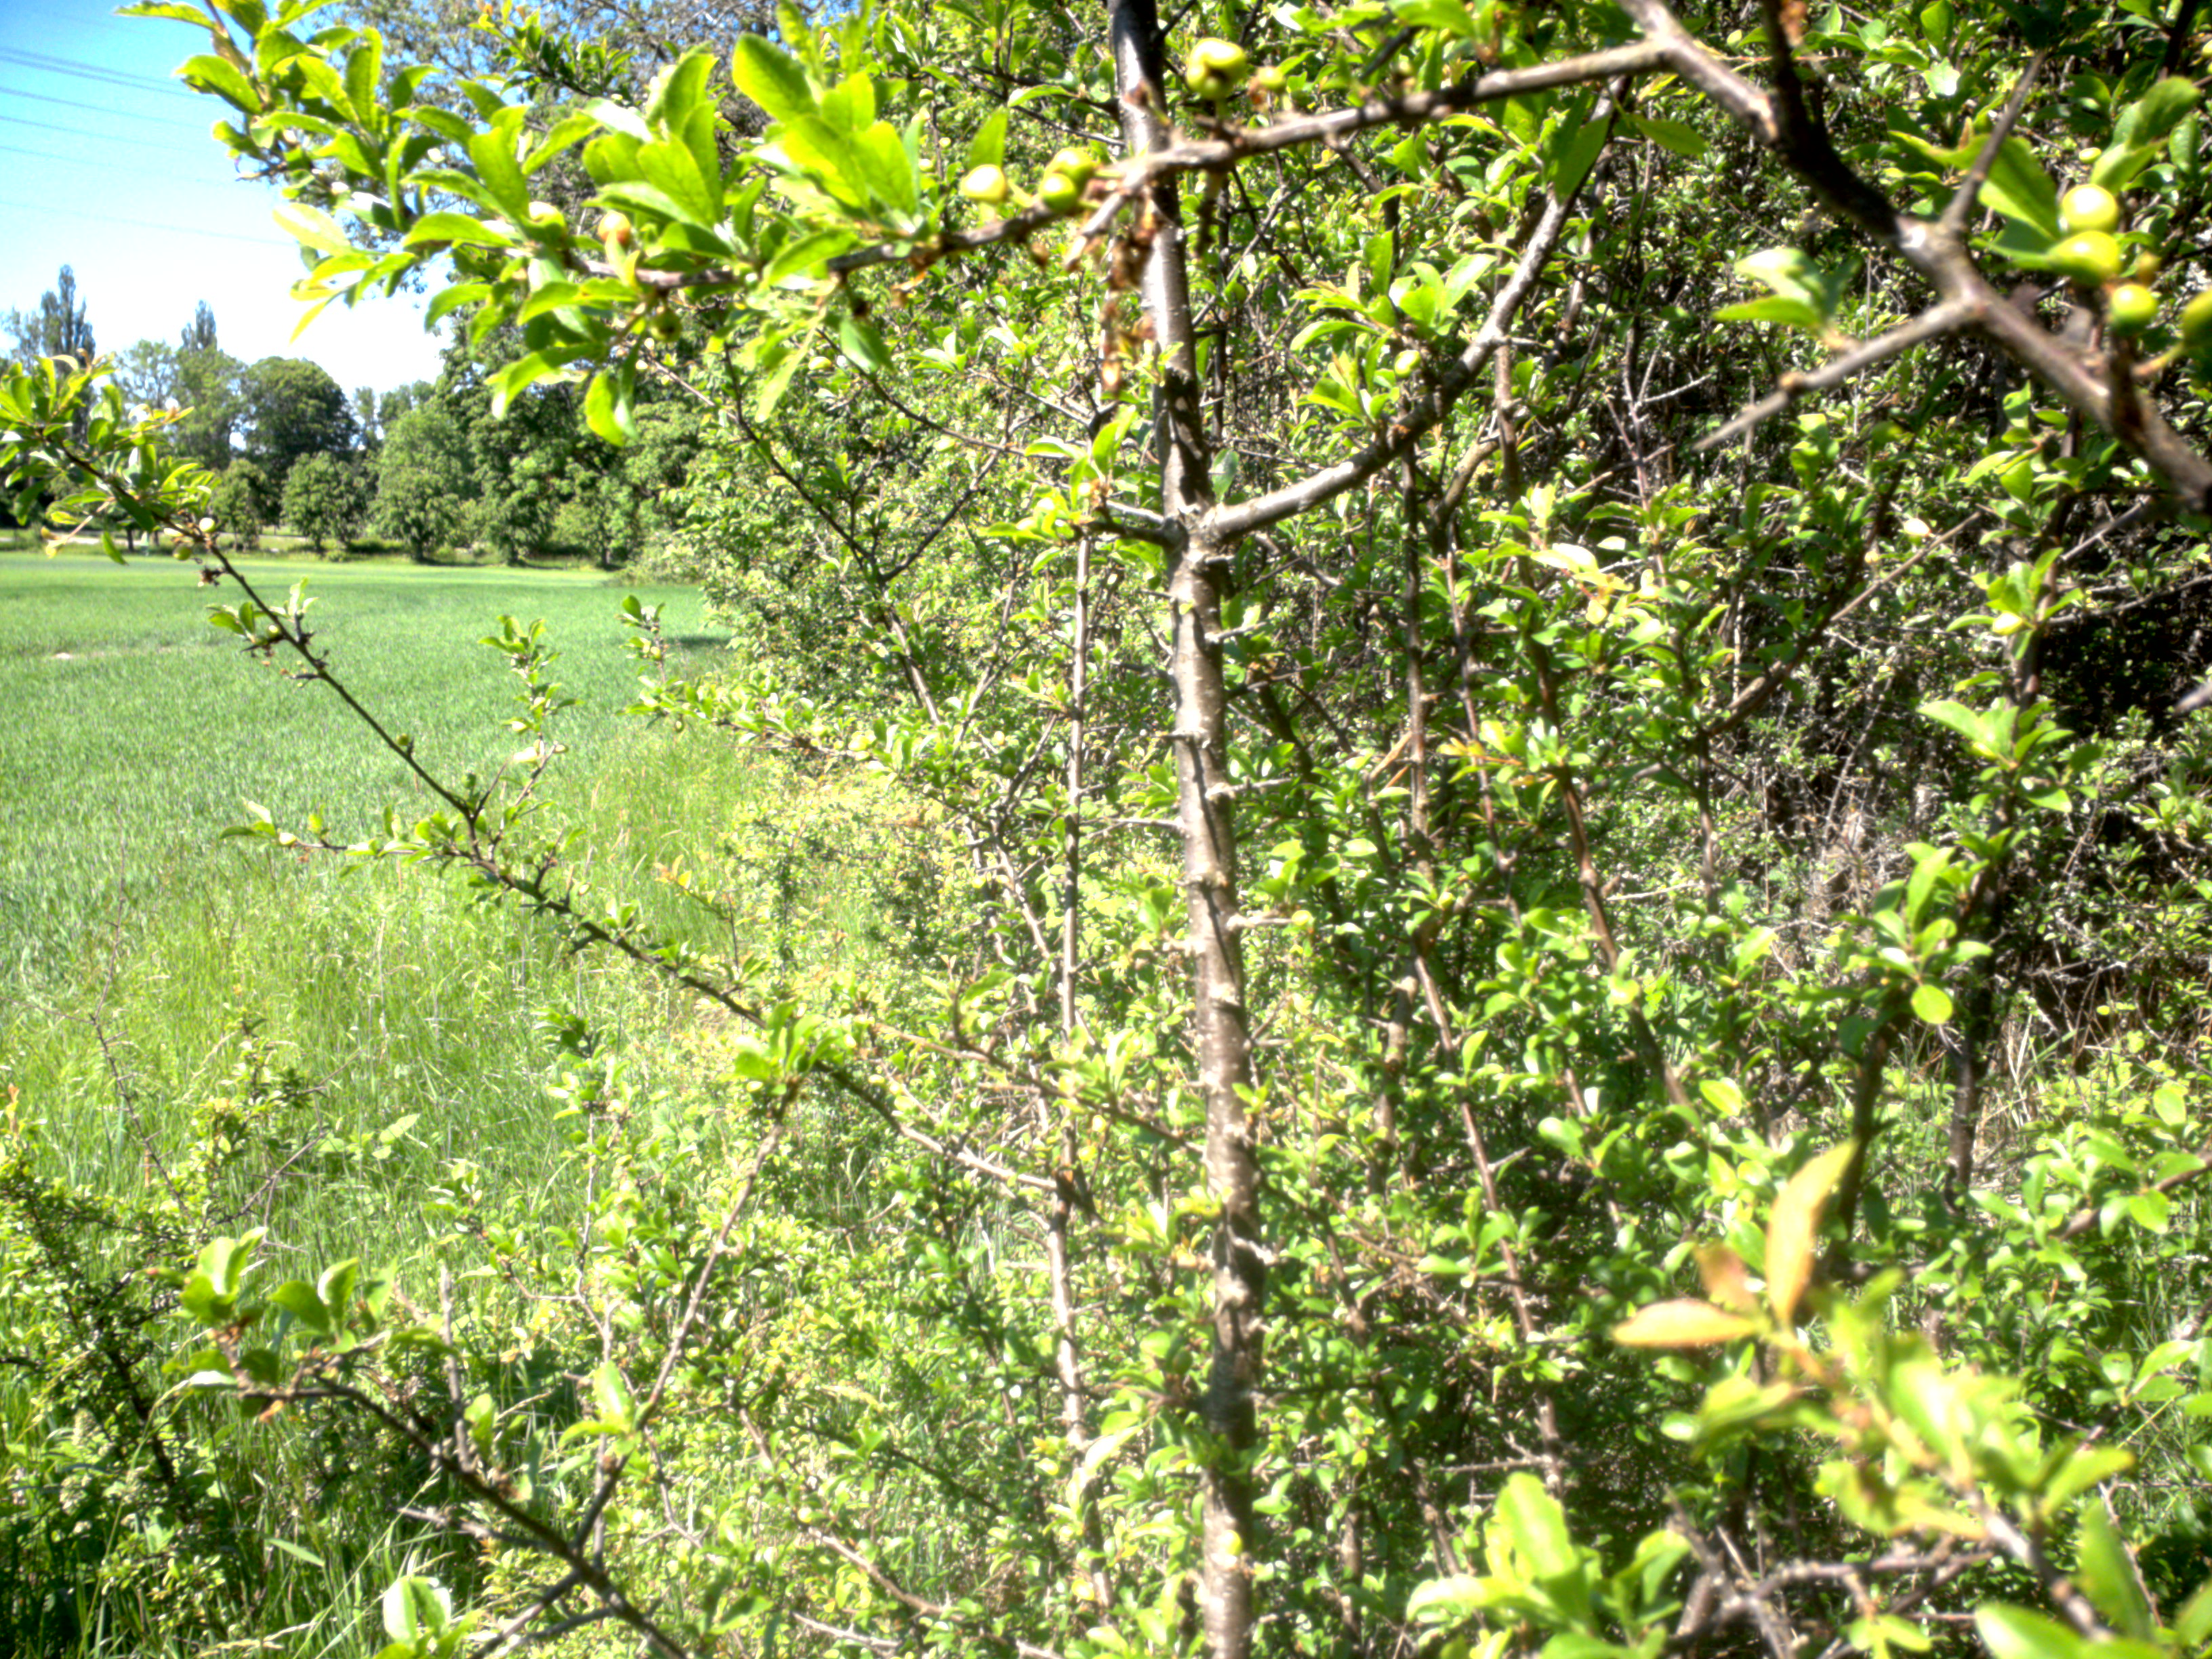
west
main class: Shrubland
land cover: Shrubland with sparse tree cover
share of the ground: > 75 %
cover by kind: shrubs 90 %, broadleaved forest trees 5 %, herbaceous plants 5 %
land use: Semi-natural and natural areas not in use
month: June
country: SE
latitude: 59.2844
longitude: 17.6675
